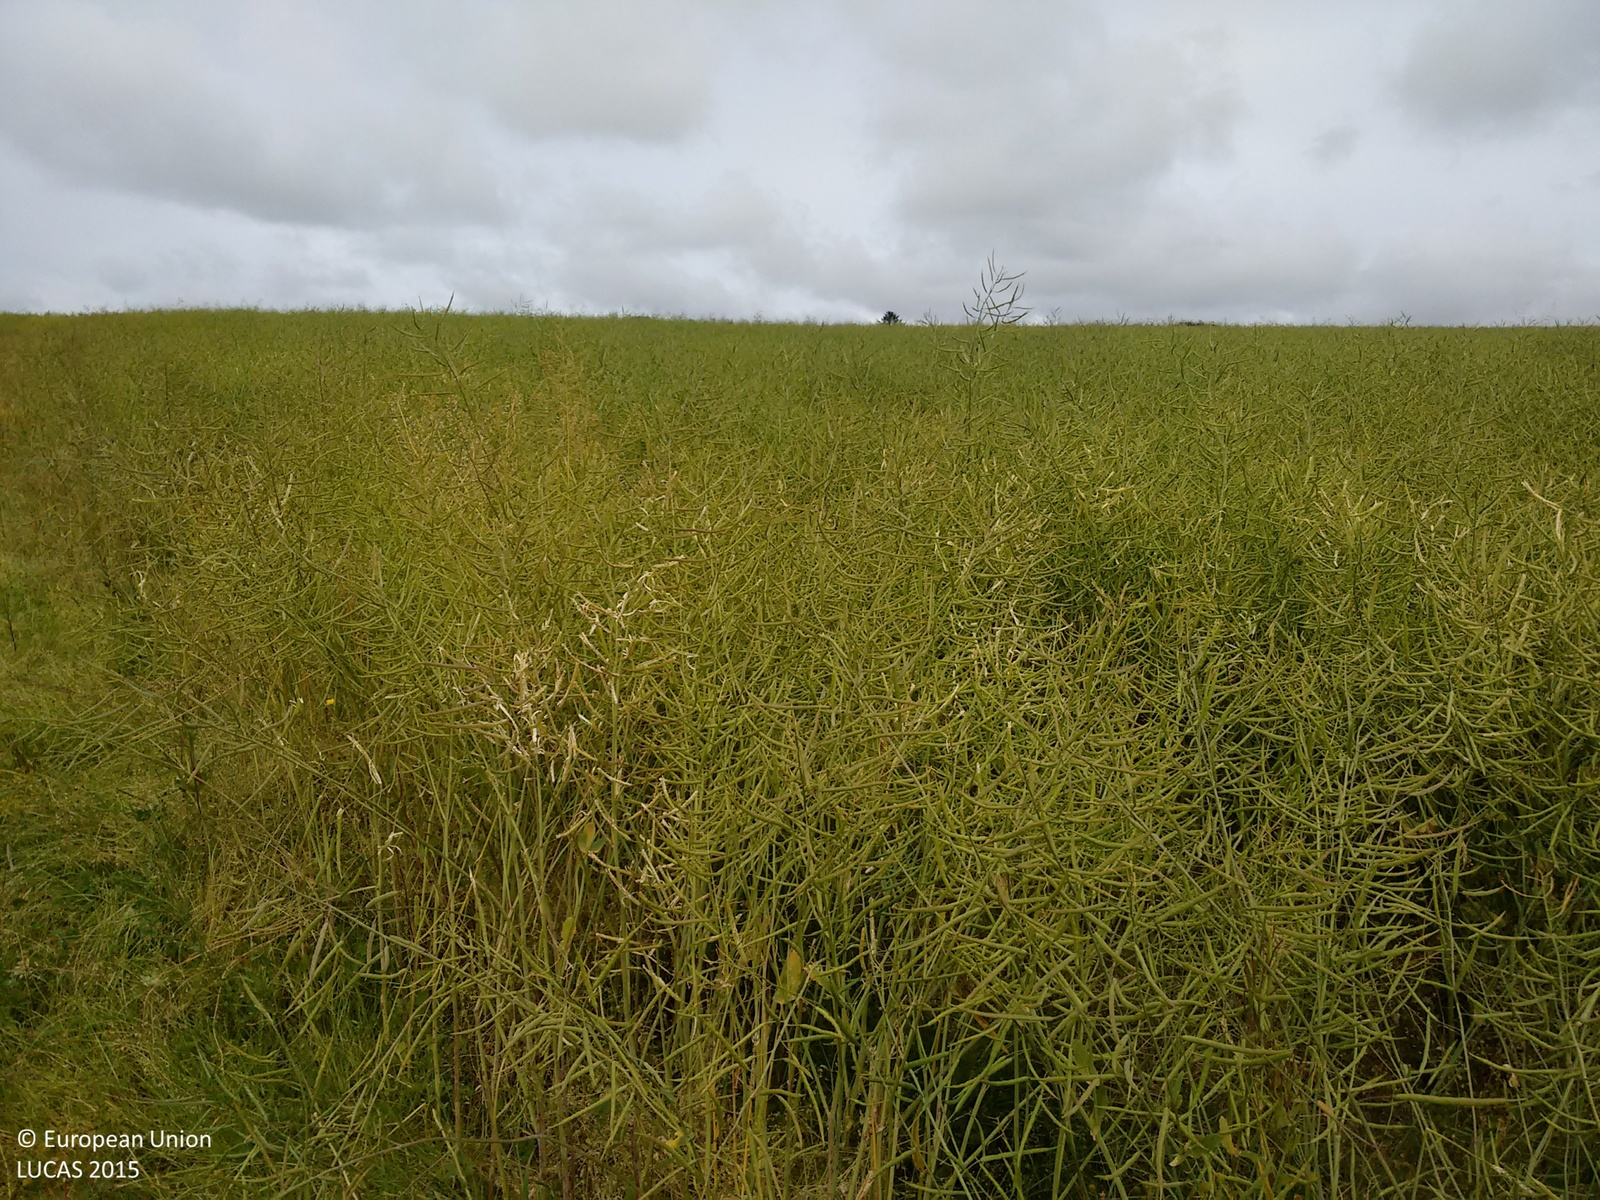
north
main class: Cropland
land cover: Rape and turnip rape
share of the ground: > 75 %
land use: Agriculture (excluding fallow land and kitchen gardens)
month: July
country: GB
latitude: 57.6043
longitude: -2.4181
